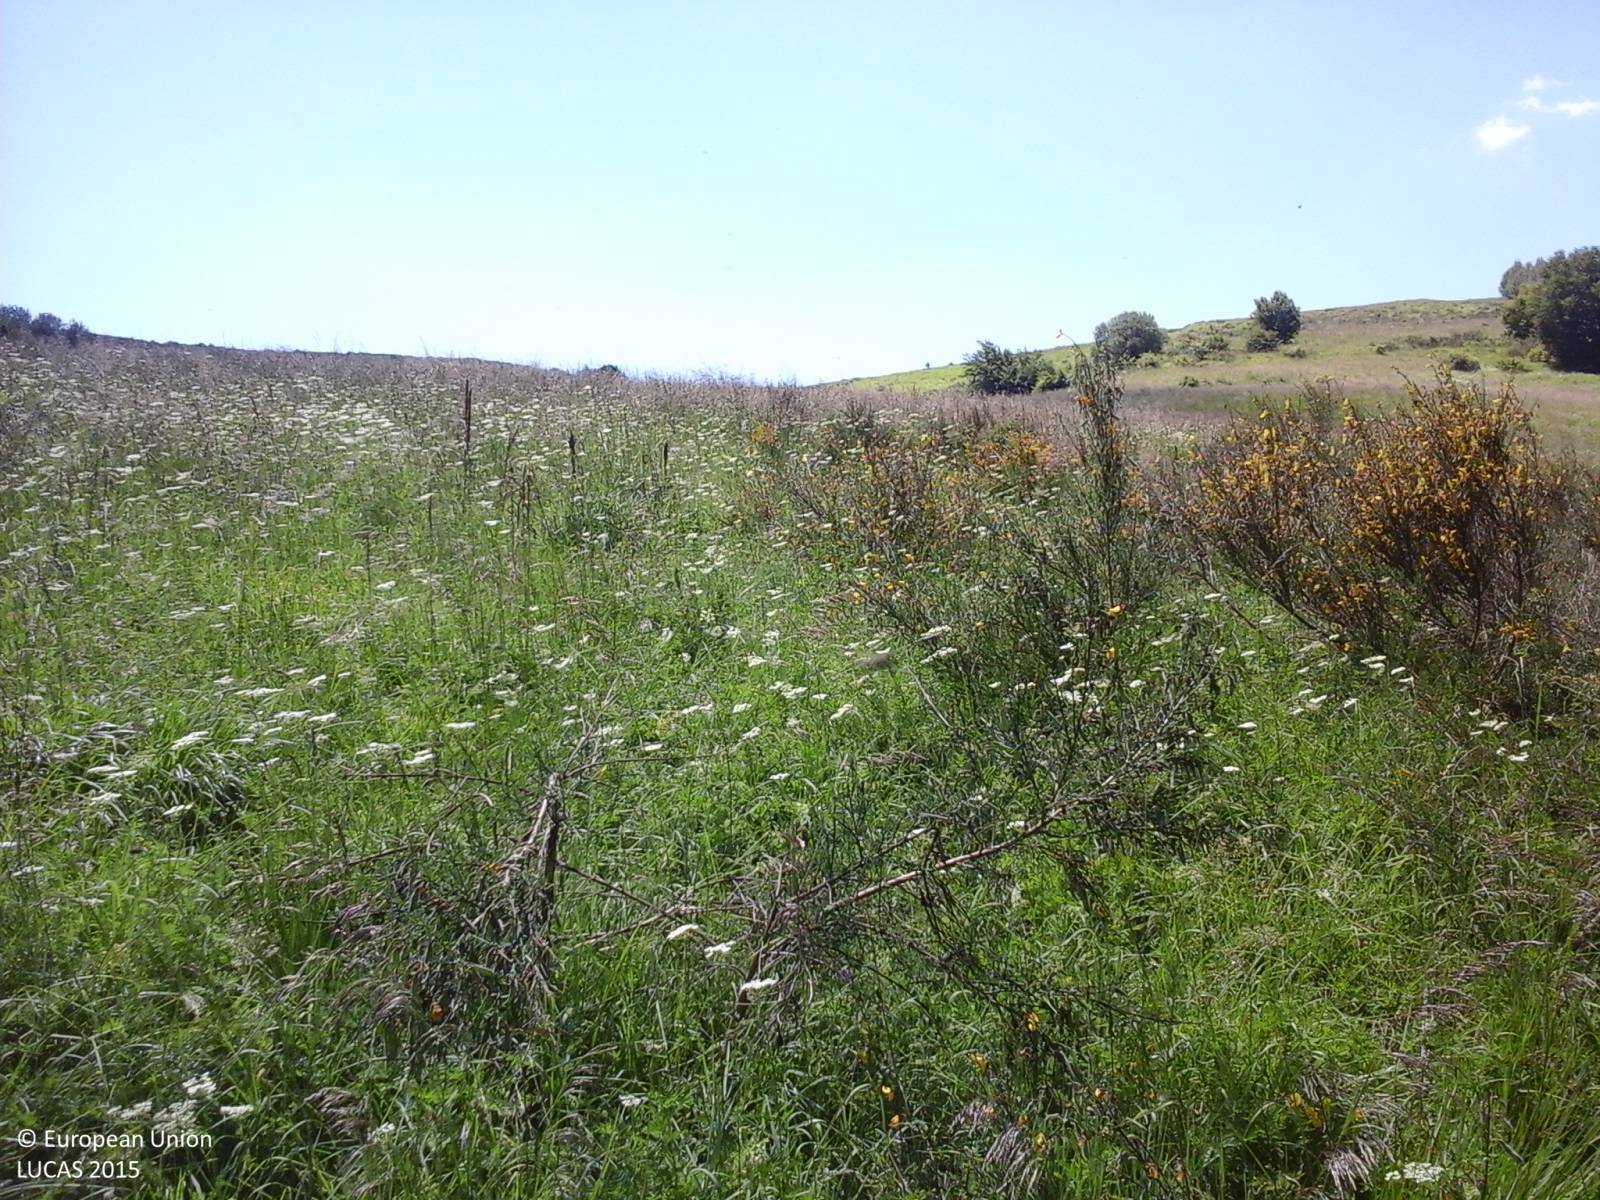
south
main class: Shrubland
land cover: Shrubland without tree cover
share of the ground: > 75 %
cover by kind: herbaceous plants 80 %, shrubs 20 %
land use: Semi-natural and natural areas not in use
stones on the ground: < 10 %
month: September
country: IT
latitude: 42.5801
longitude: 13.3647
